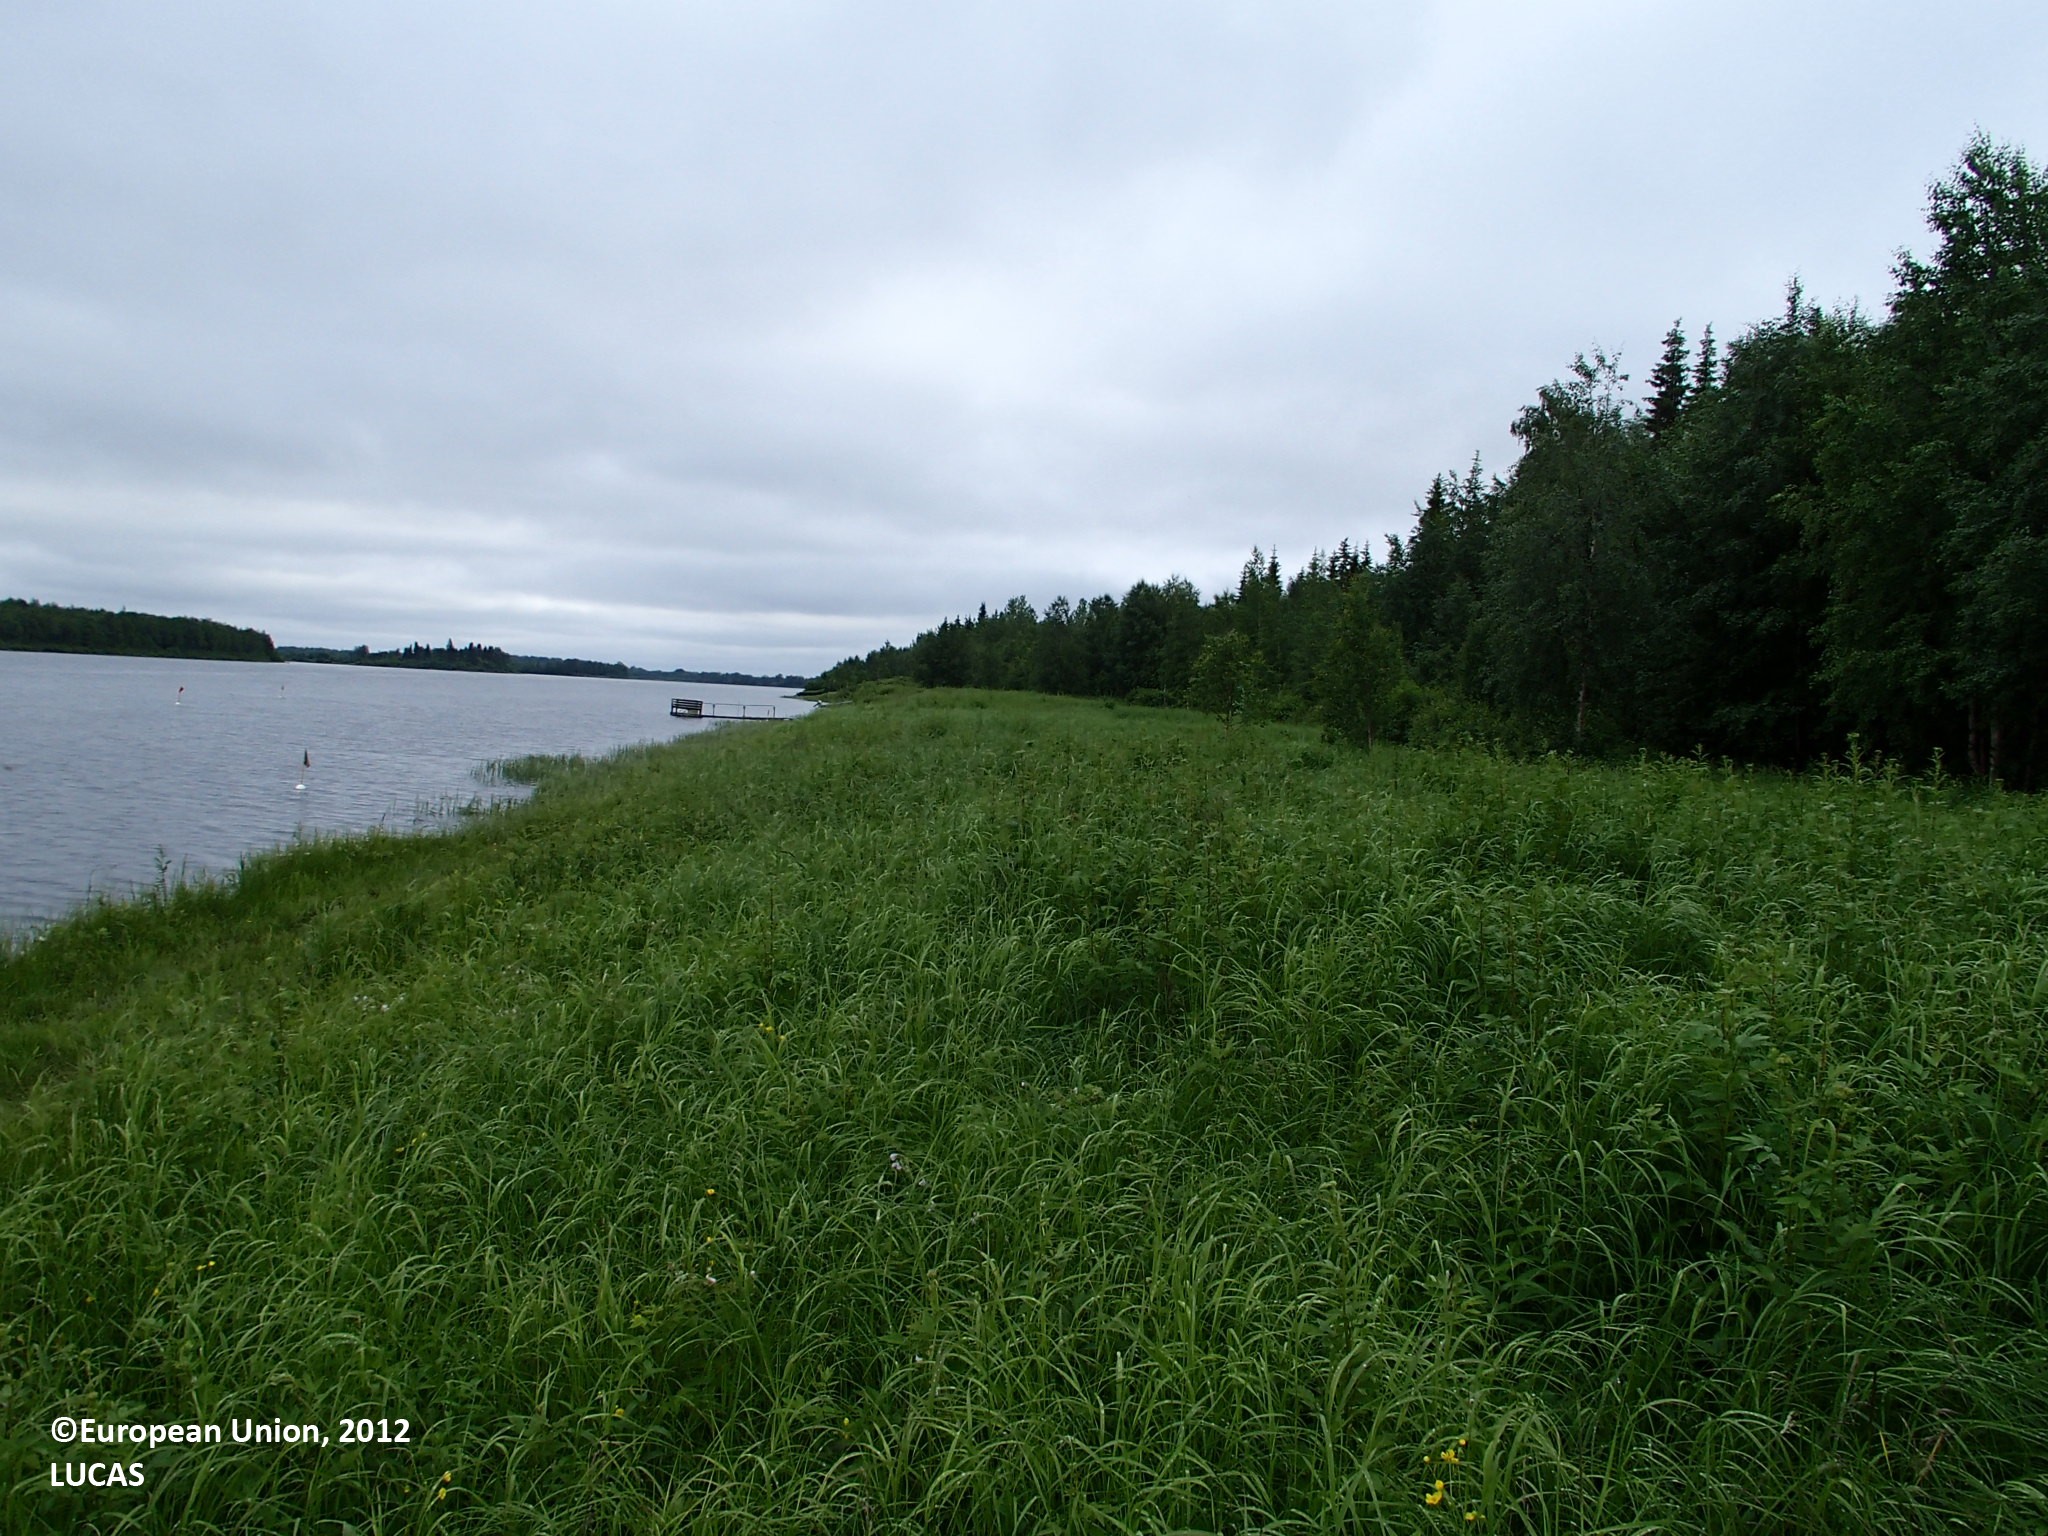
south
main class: Grassland
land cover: Grassland without tree/shrub cover
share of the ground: > 75 %
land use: Amenities, museums, leisure
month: July
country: FI
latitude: 66.9875
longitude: 27.5522
